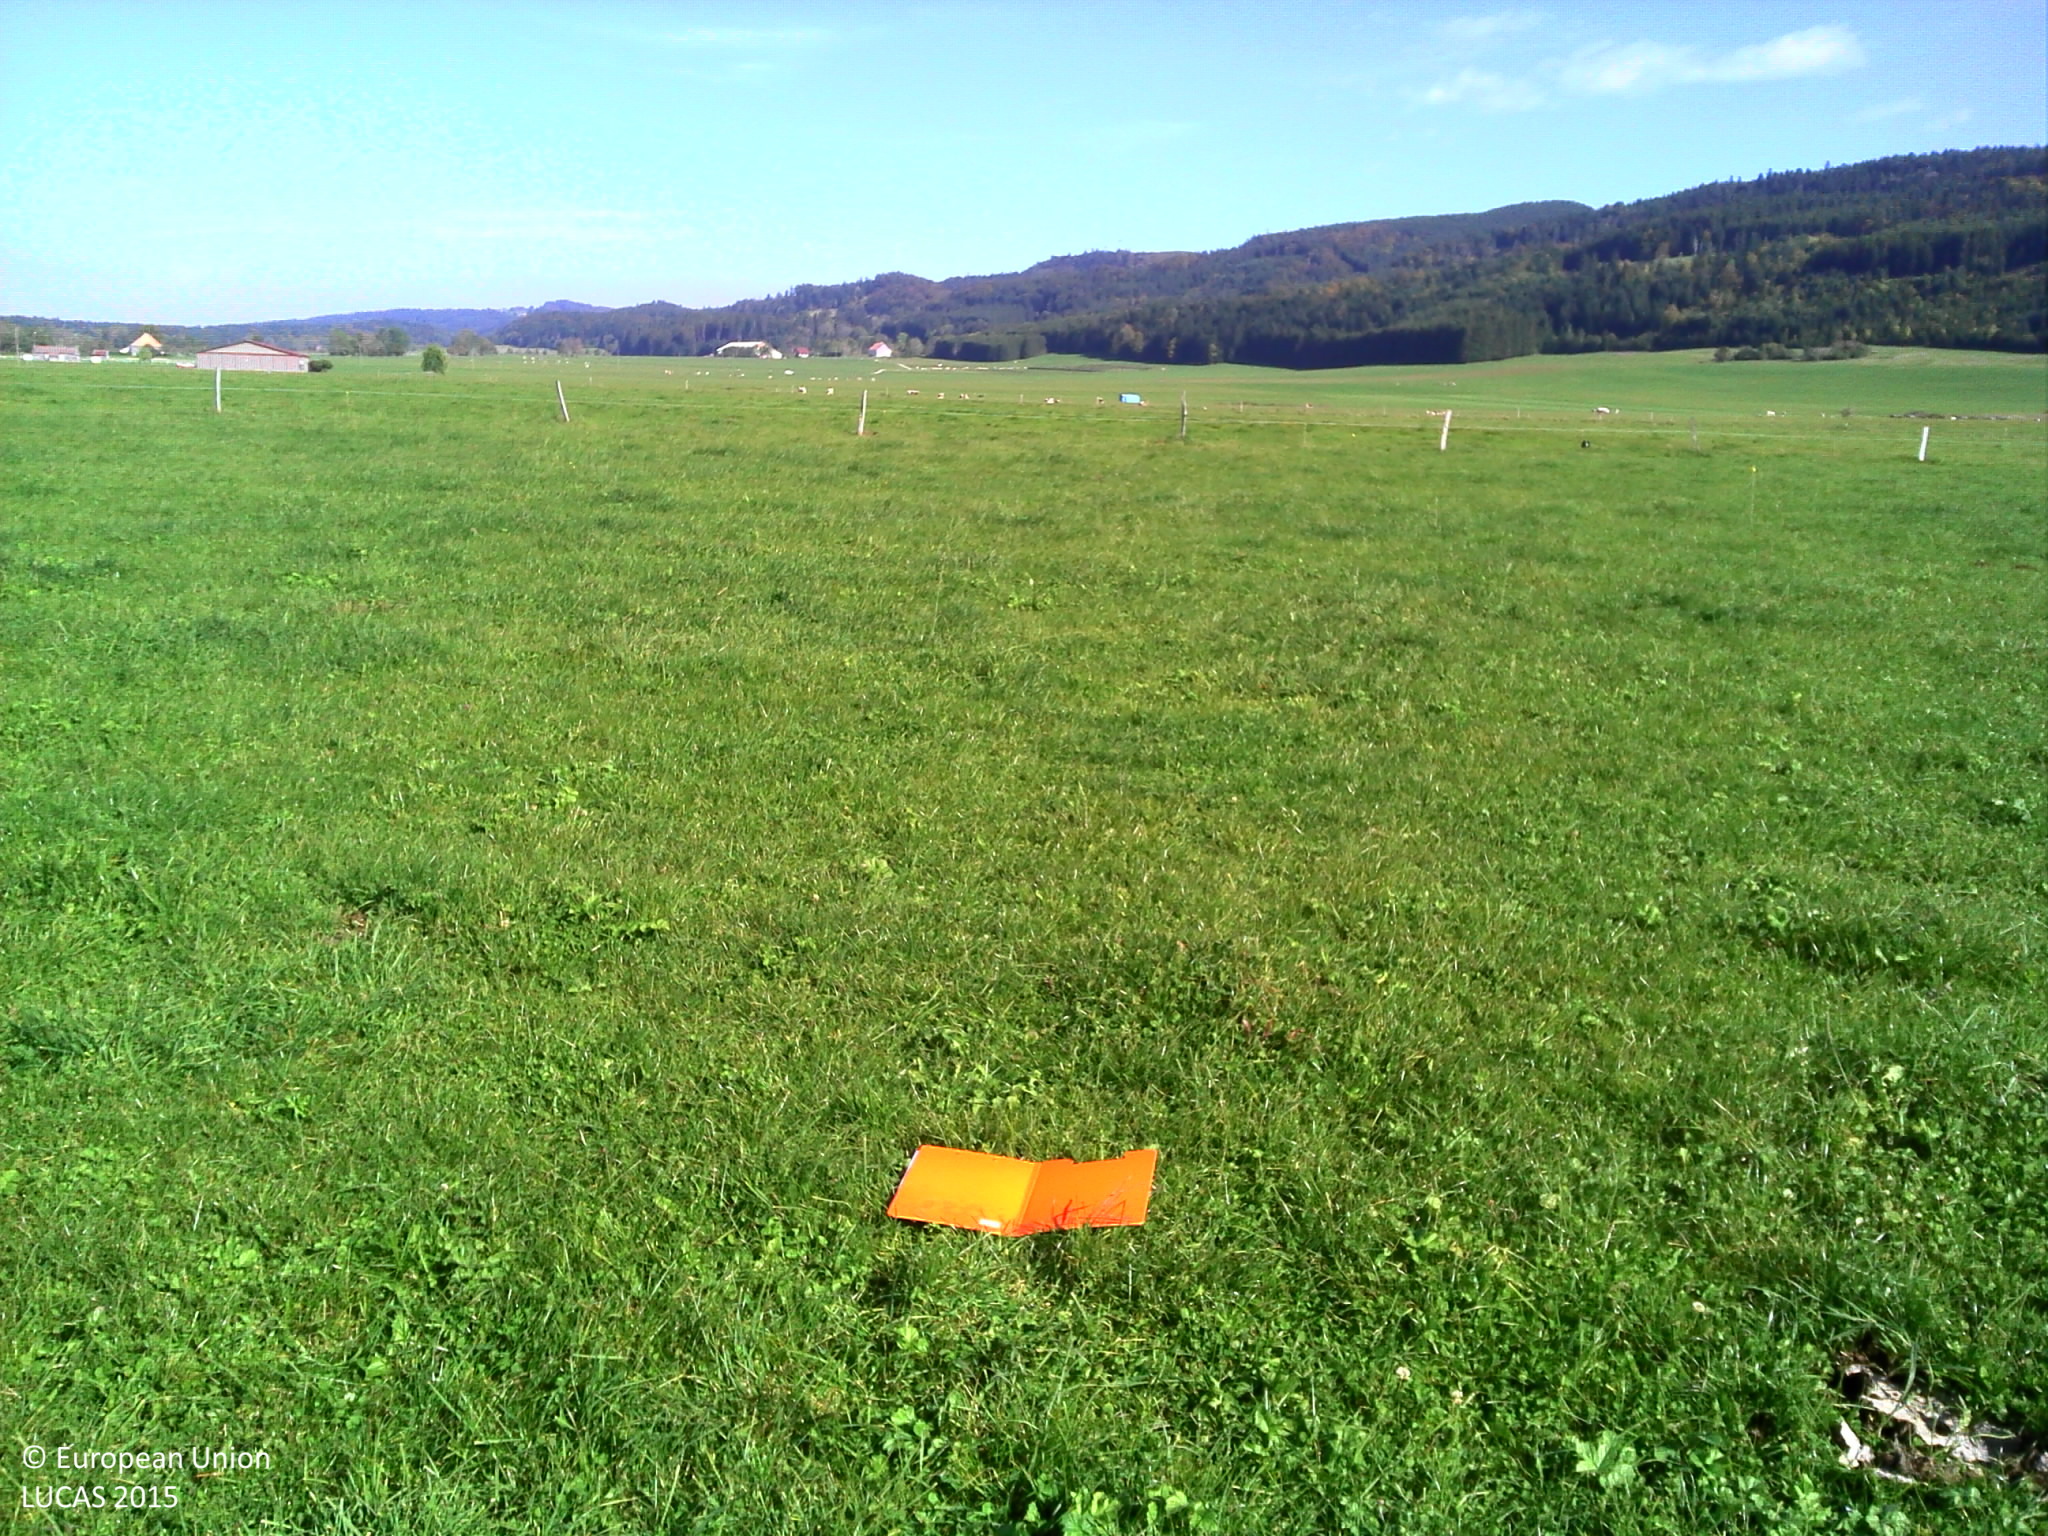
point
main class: Grassland
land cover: Grassland without tree/shrub cover
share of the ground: > 75 %
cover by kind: herbaceous plants 100 %
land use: Agriculture (excluding fallow land and kitchen gardens)
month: October
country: FR
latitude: 47.0471
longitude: 6.3825
